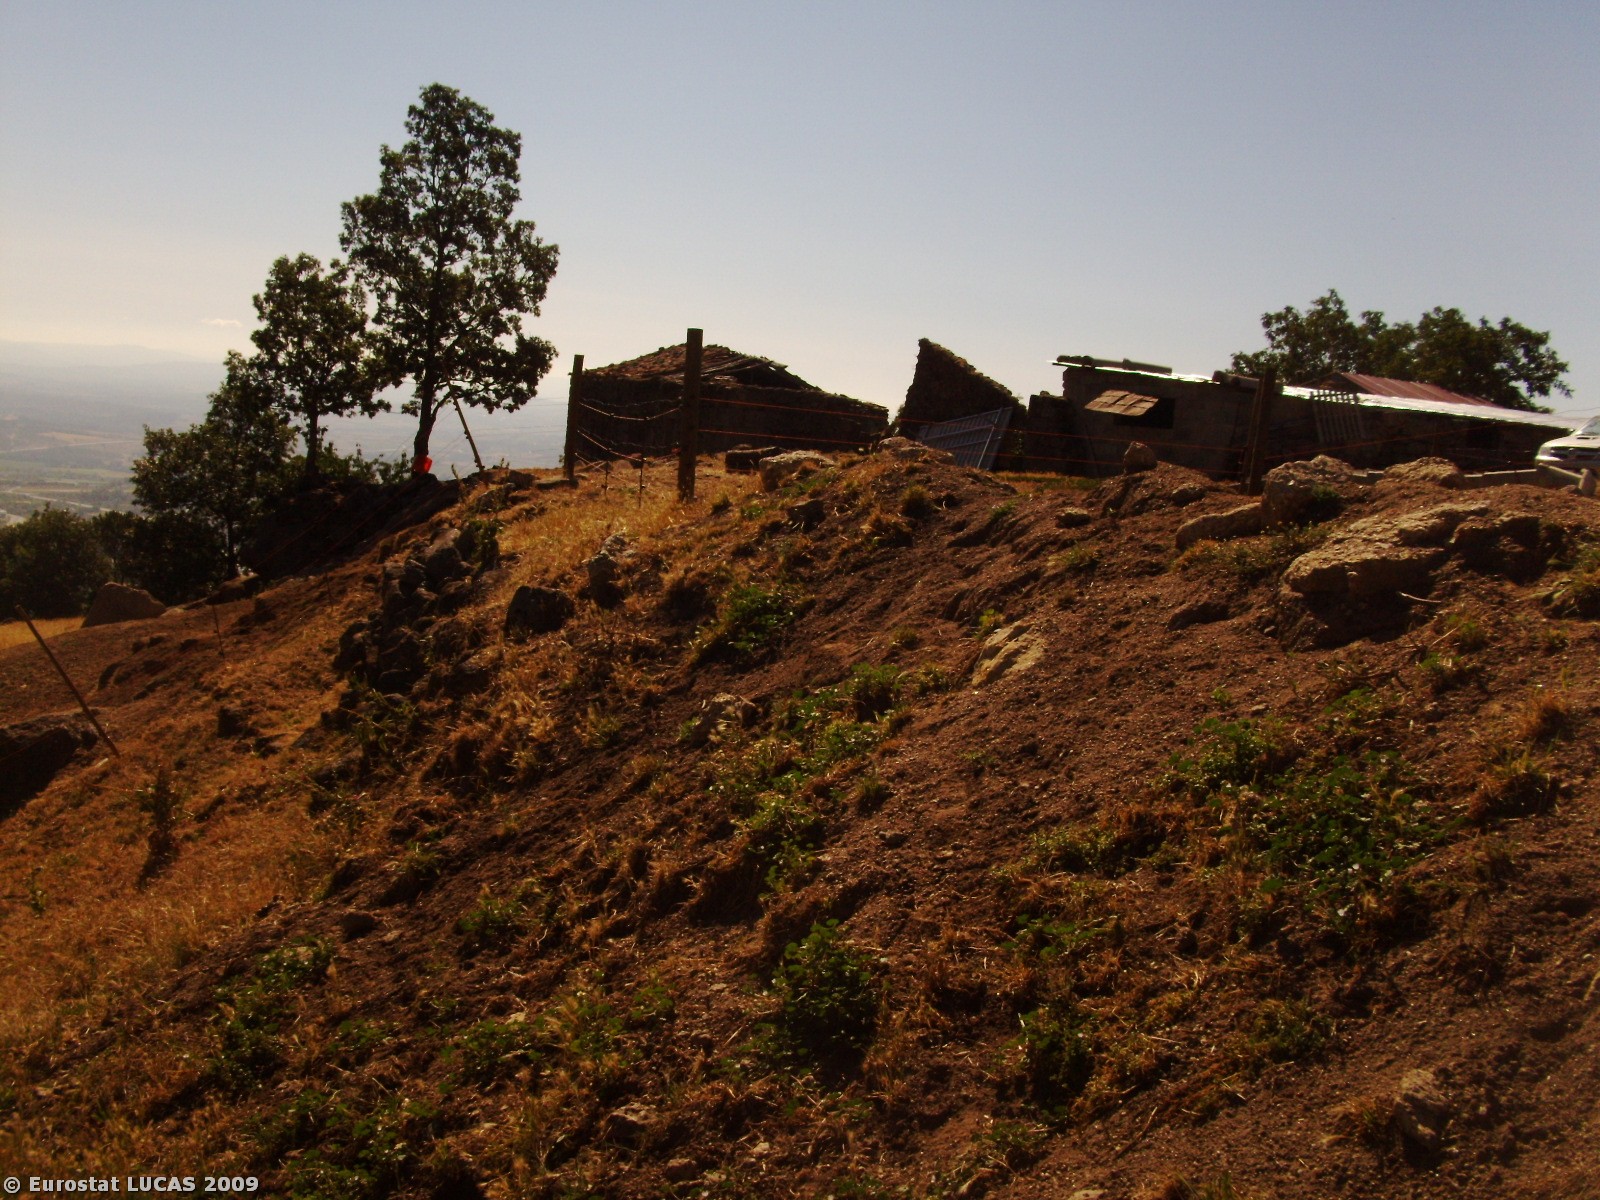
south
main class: Grassland
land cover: Spontaneously vegetated surfaces
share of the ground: > 75 %
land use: Fallow land
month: July
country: PT
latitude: 40.2640
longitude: -7.5221
